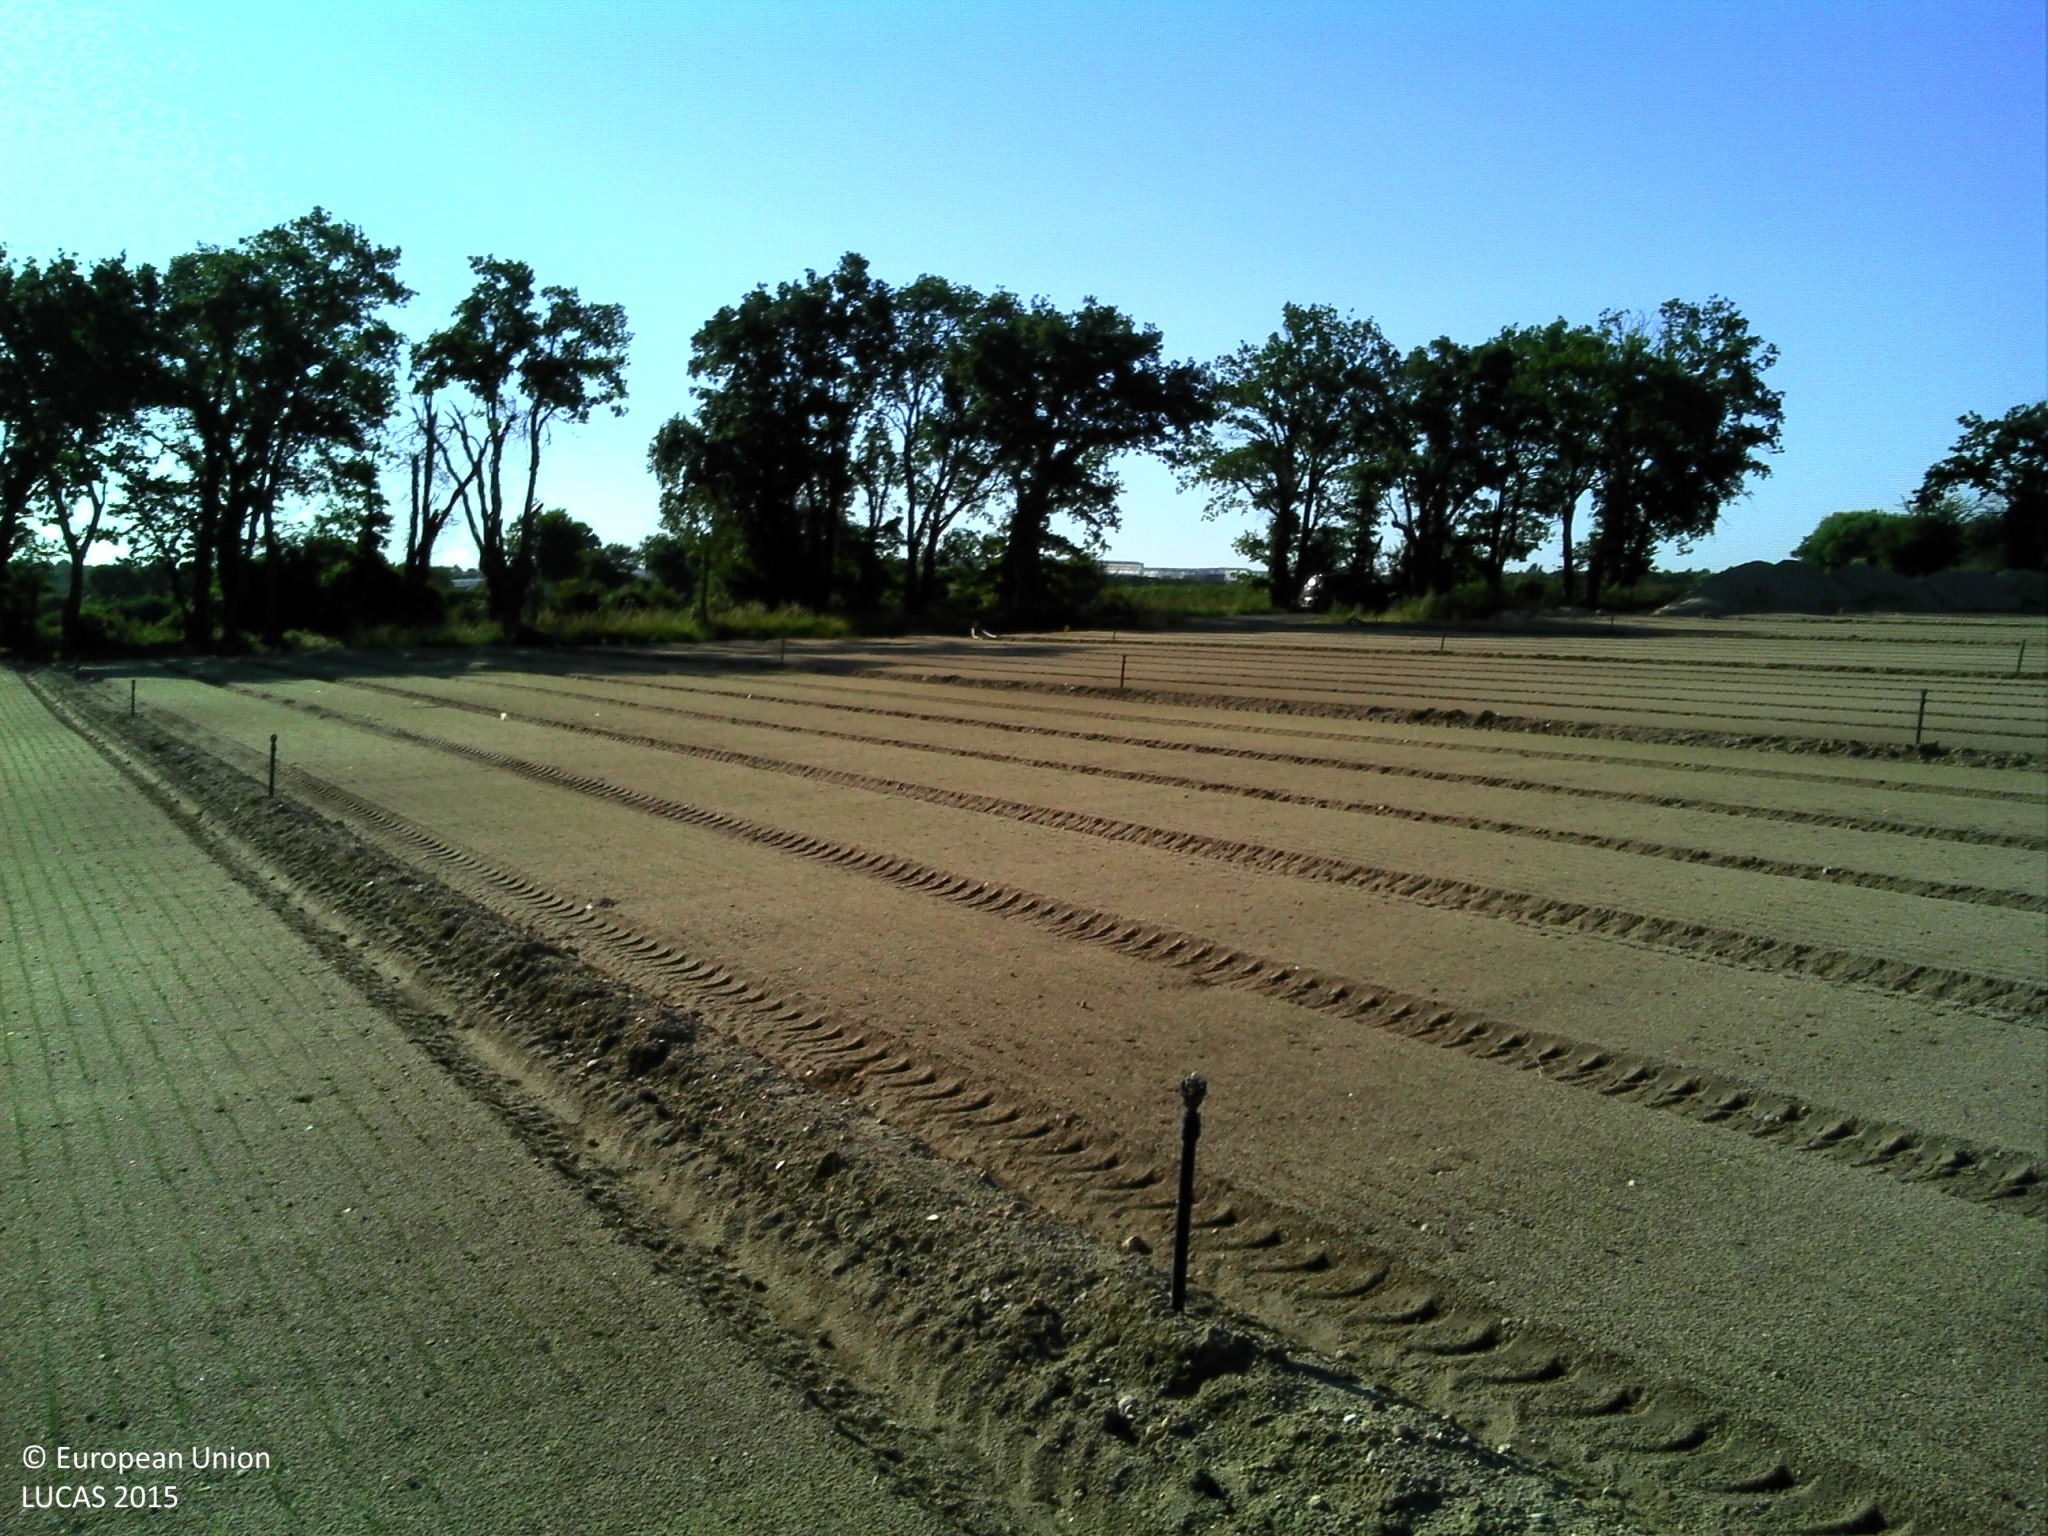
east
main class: Cropland
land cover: Other fresh vegetables
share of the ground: < 10 %
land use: Agriculture (excluding fallow land and kitchen gardens)
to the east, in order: Other fresh vegetables; Other bare soil; Lines of trees; Ditches and canals; Grass margins; Paved roads, cycling and walking lanes; Grass margins; Ditches and canals; Abandoned hedges; Other fresh vegetables; Abandoned hedges; Fences; Maize
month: June
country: FR
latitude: 47.2972
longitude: -1.4540
